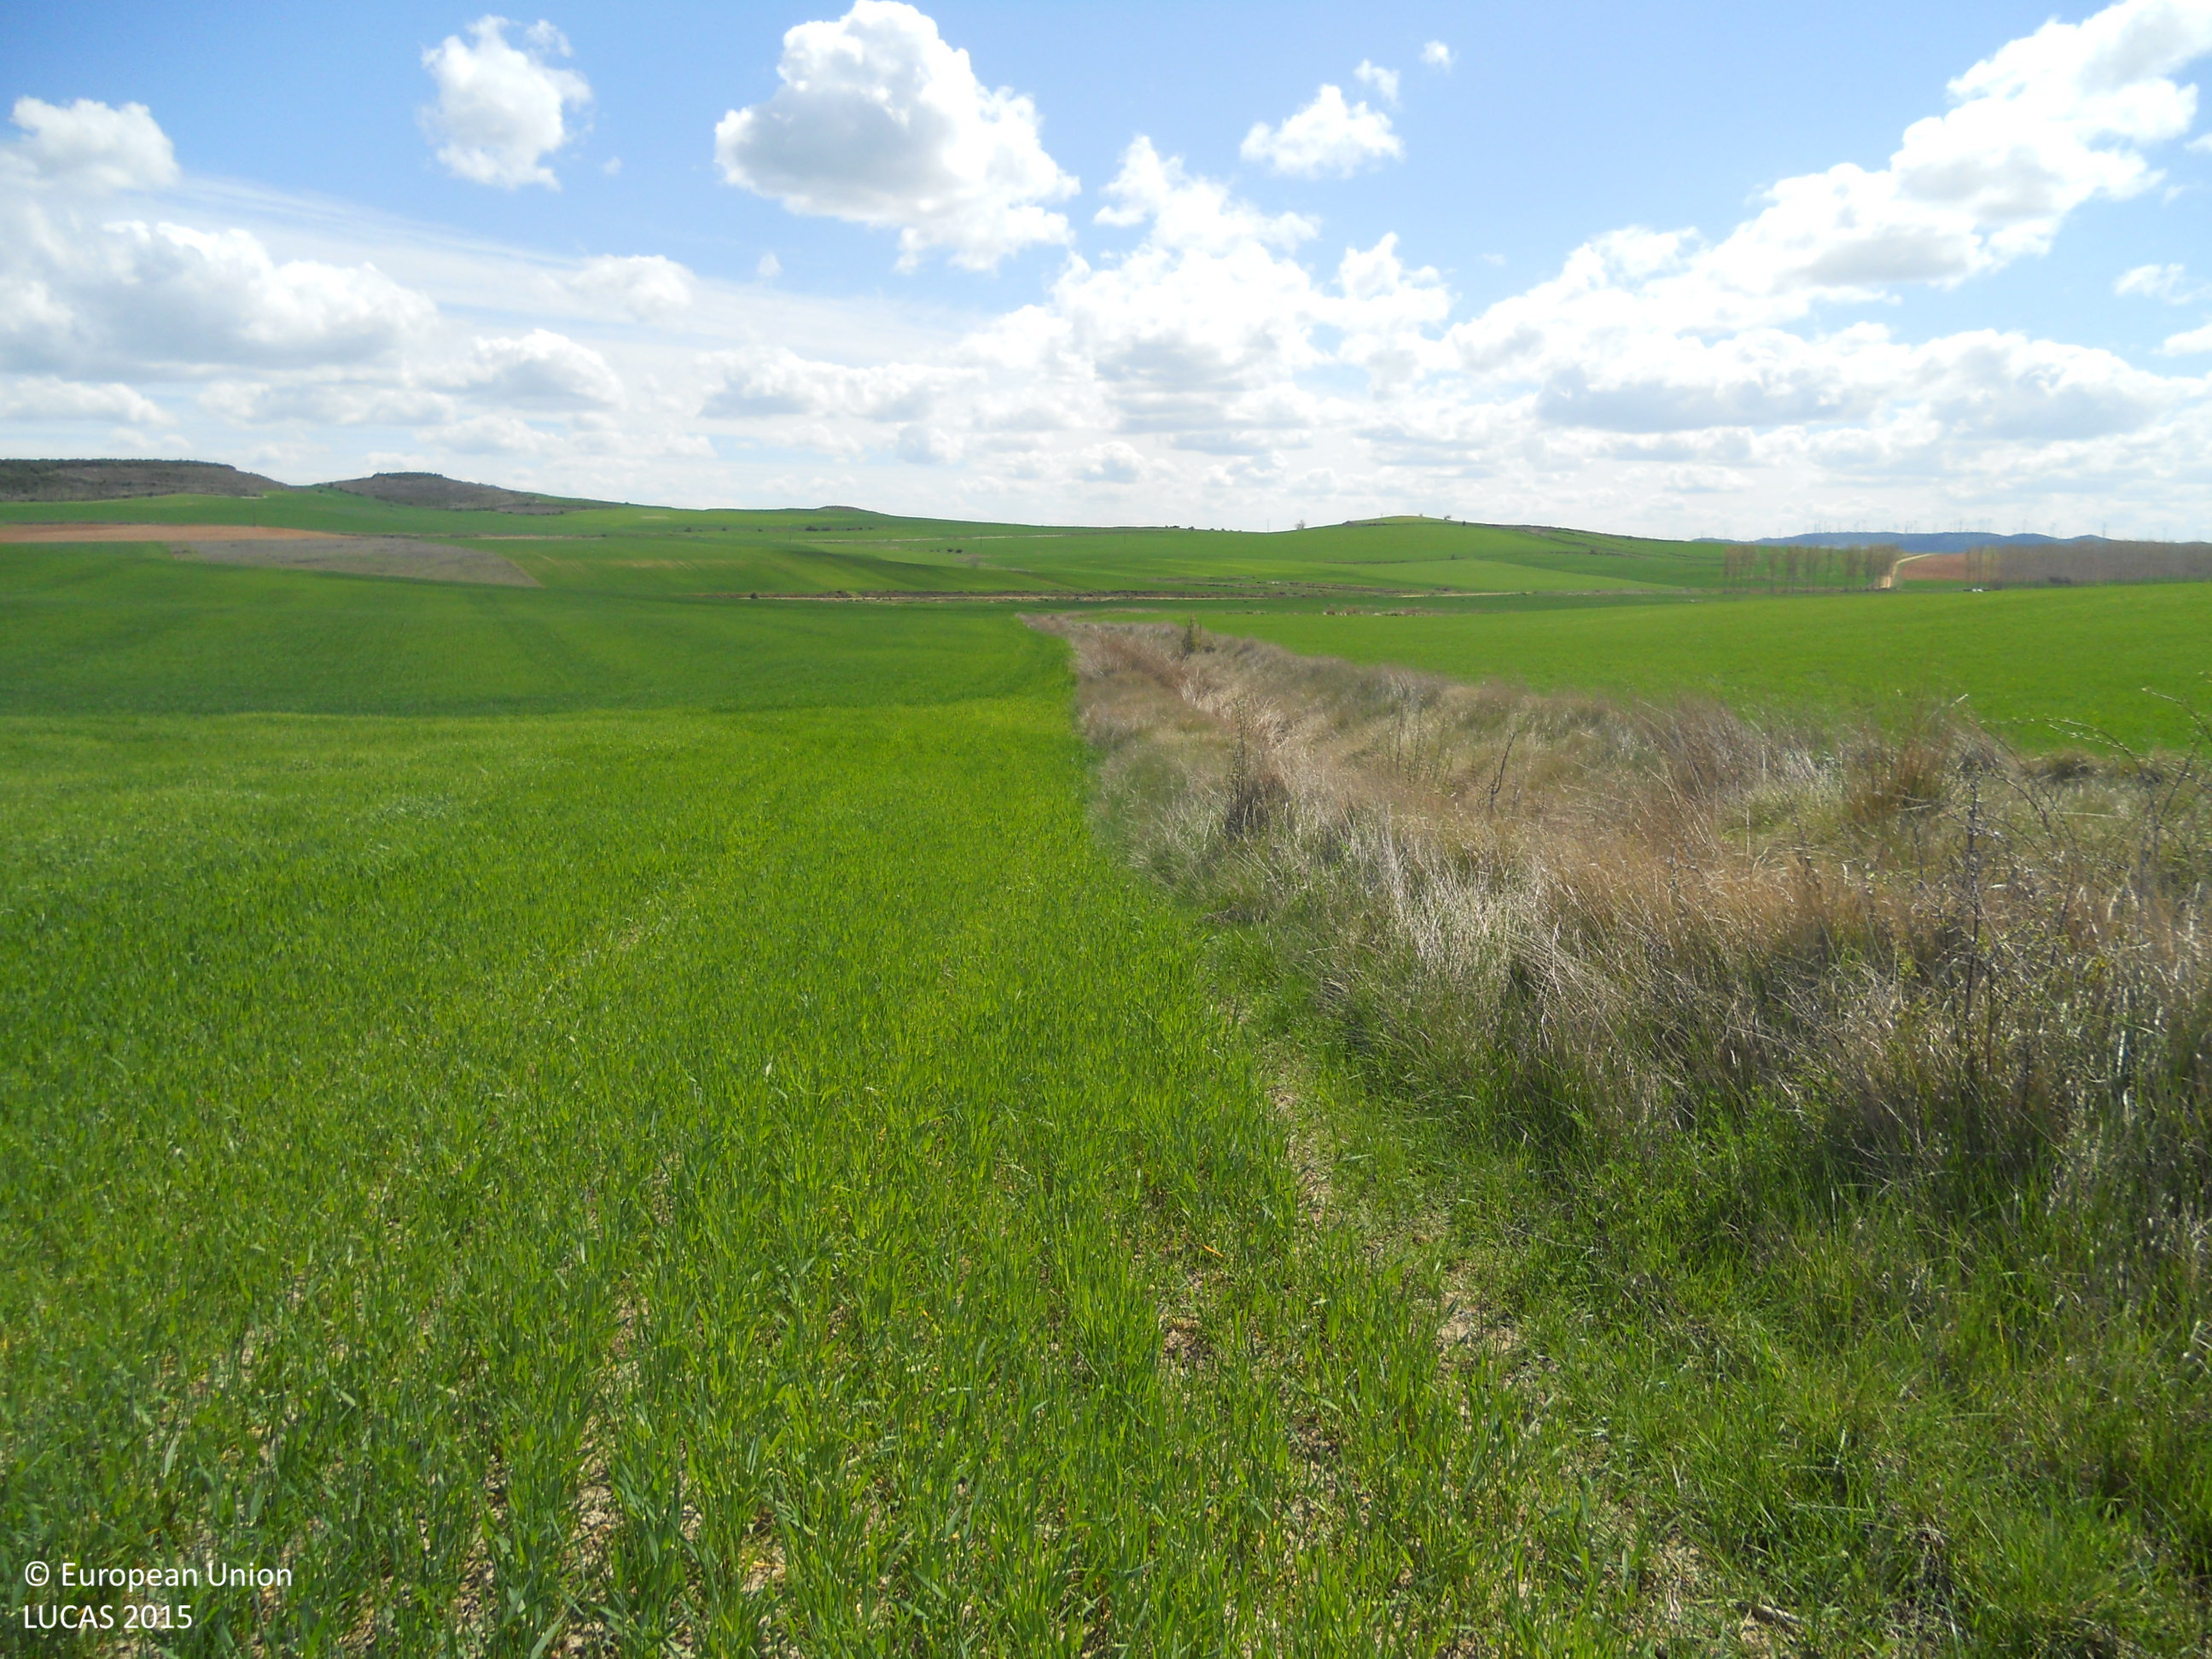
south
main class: Cropland
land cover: Barley
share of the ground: > 75 %
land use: Agriculture (excluding fallow land and kitchen gardens)
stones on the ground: < 10 %
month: April
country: ES
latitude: 42.3034
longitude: -4.2248
